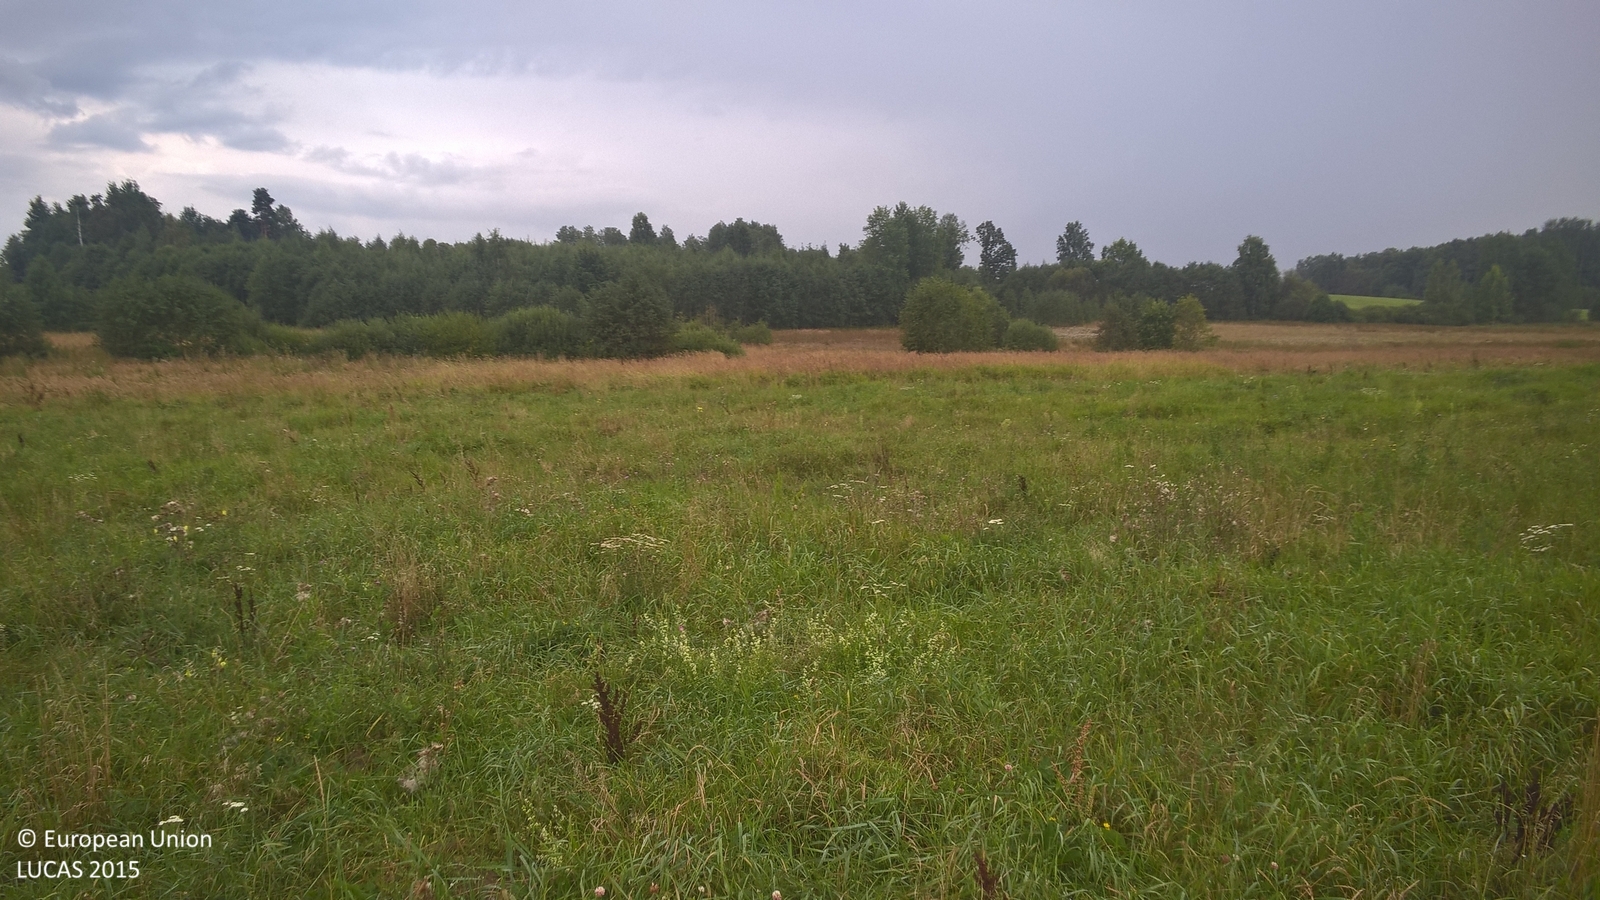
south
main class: Grassland
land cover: Spontaneously vegetated surfaces
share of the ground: > 75 %
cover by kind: herbaceous plants 100 %
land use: Fallow land
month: September
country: LV
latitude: 57.3598
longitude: 25.5606
